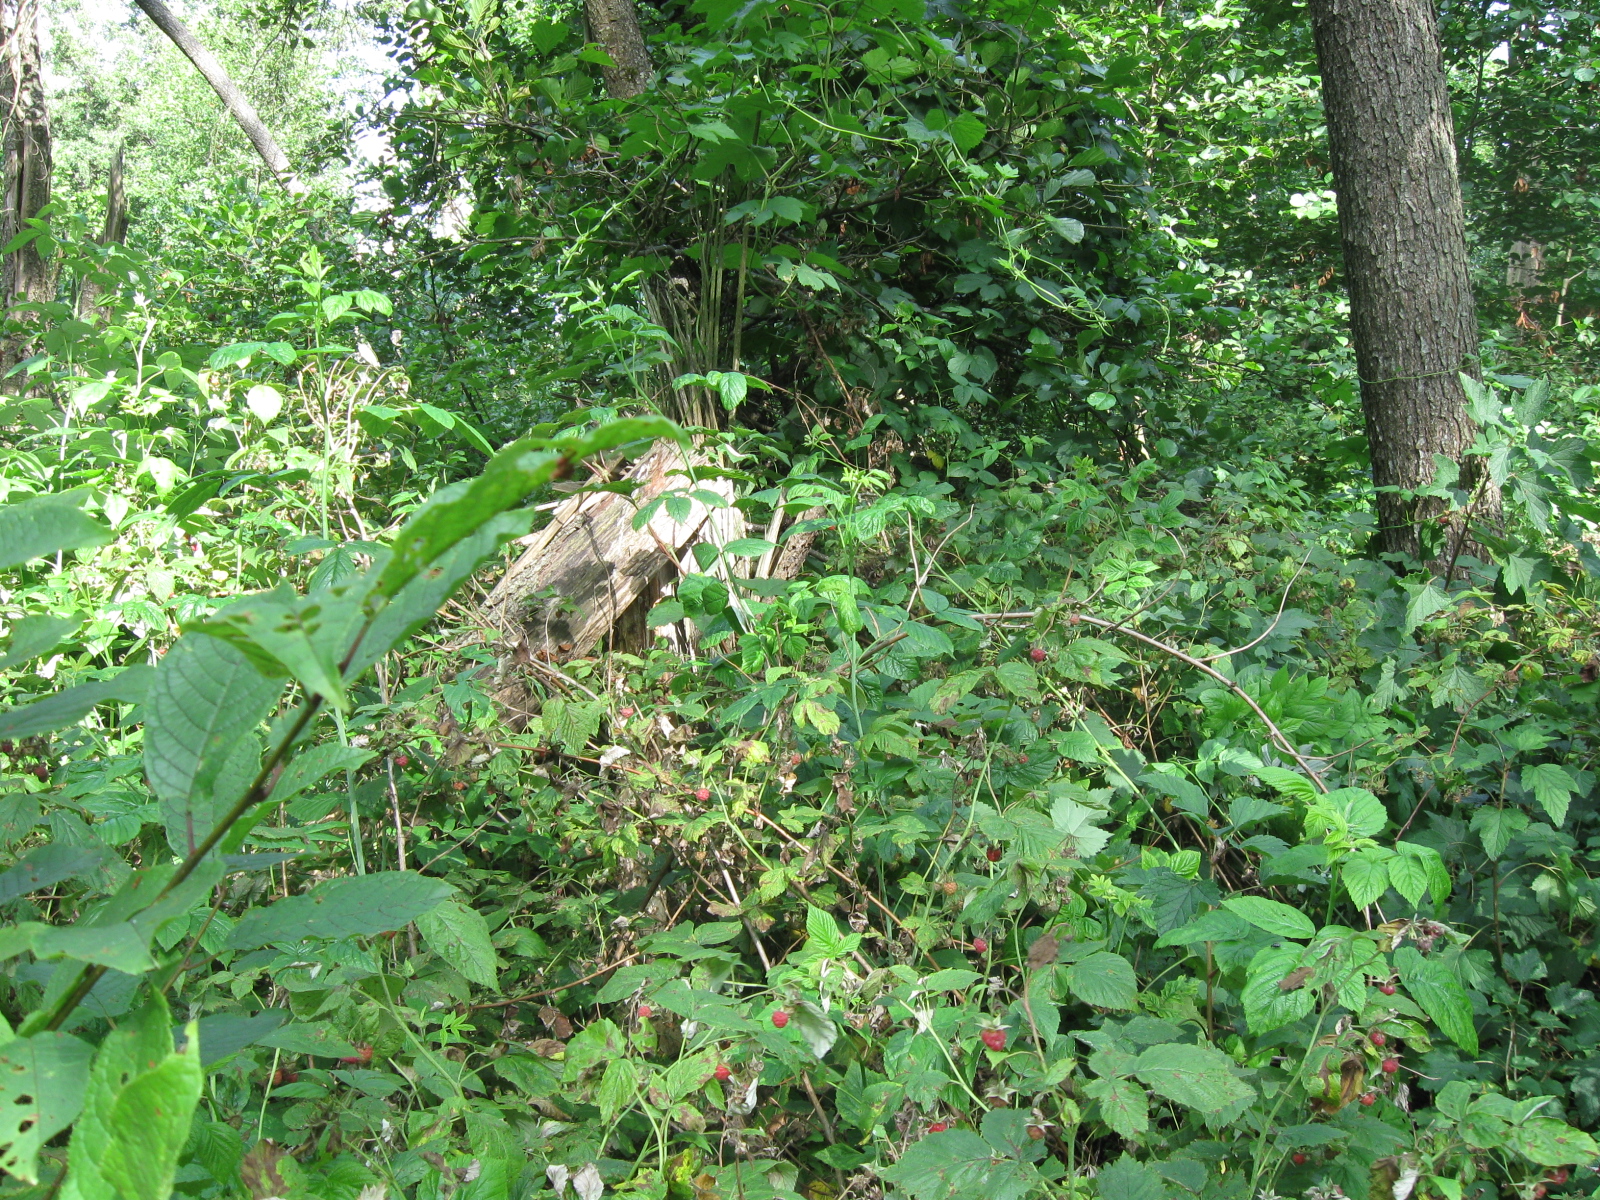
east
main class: Woodland
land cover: Broadleaved woodland
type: mire and swamp forests
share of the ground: > 75 %
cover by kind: broadleaved forest trees 75 %, shrubs 20 %, herbaceous plants 5 %
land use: Forestry
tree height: > 5 m
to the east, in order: Broadleaved woodland; Spontaneously vegetated surfaces; Apple fruit; Spontaneously vegetated surfaces; Grassland with sparse tree/shrub cover; Grassland without tree/shrub cover
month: July
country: LT
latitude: 54.5287
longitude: 24.3939
